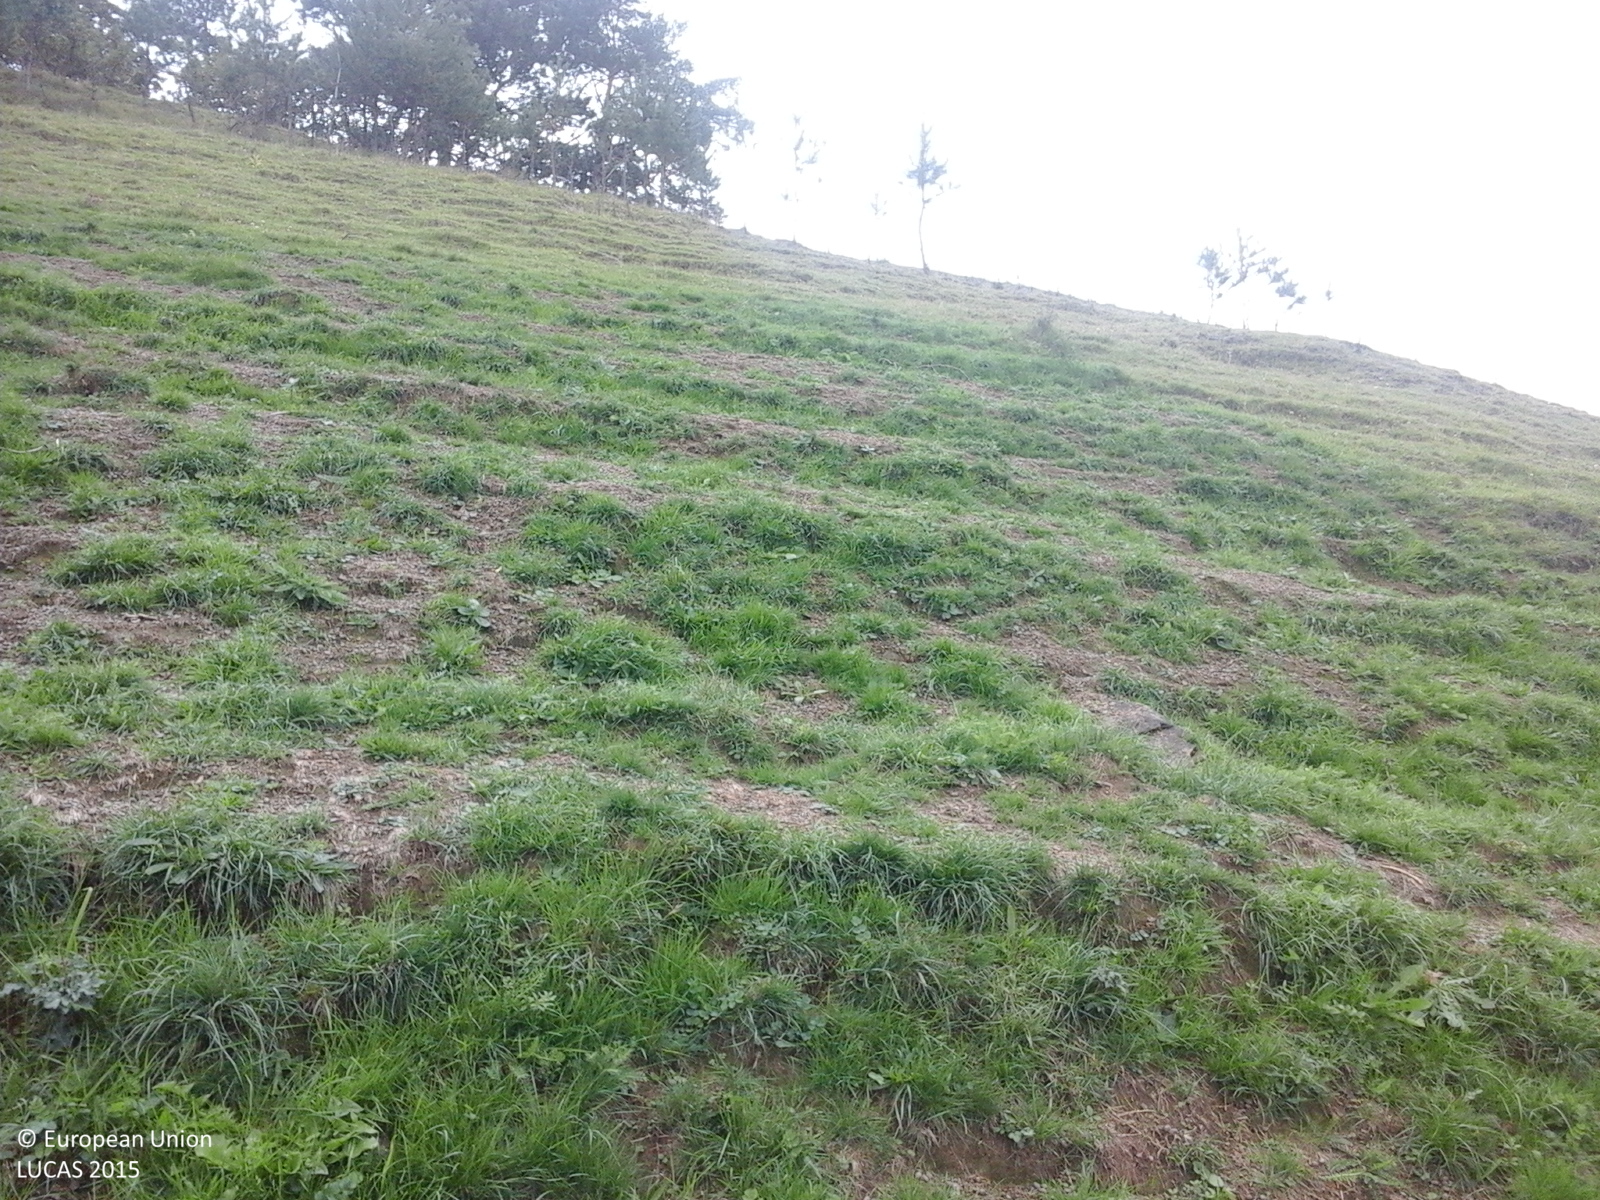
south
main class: Grassland
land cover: Grassland without tree/shrub cover
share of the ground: > 75 %
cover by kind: herbaceous plants 85 %, unconsolidated bare surface 15 %
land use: Agriculture (excluding fallow land and kitchen gardens)
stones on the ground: < 10 %
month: October
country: RO
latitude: 46.1476
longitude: 24.7320
